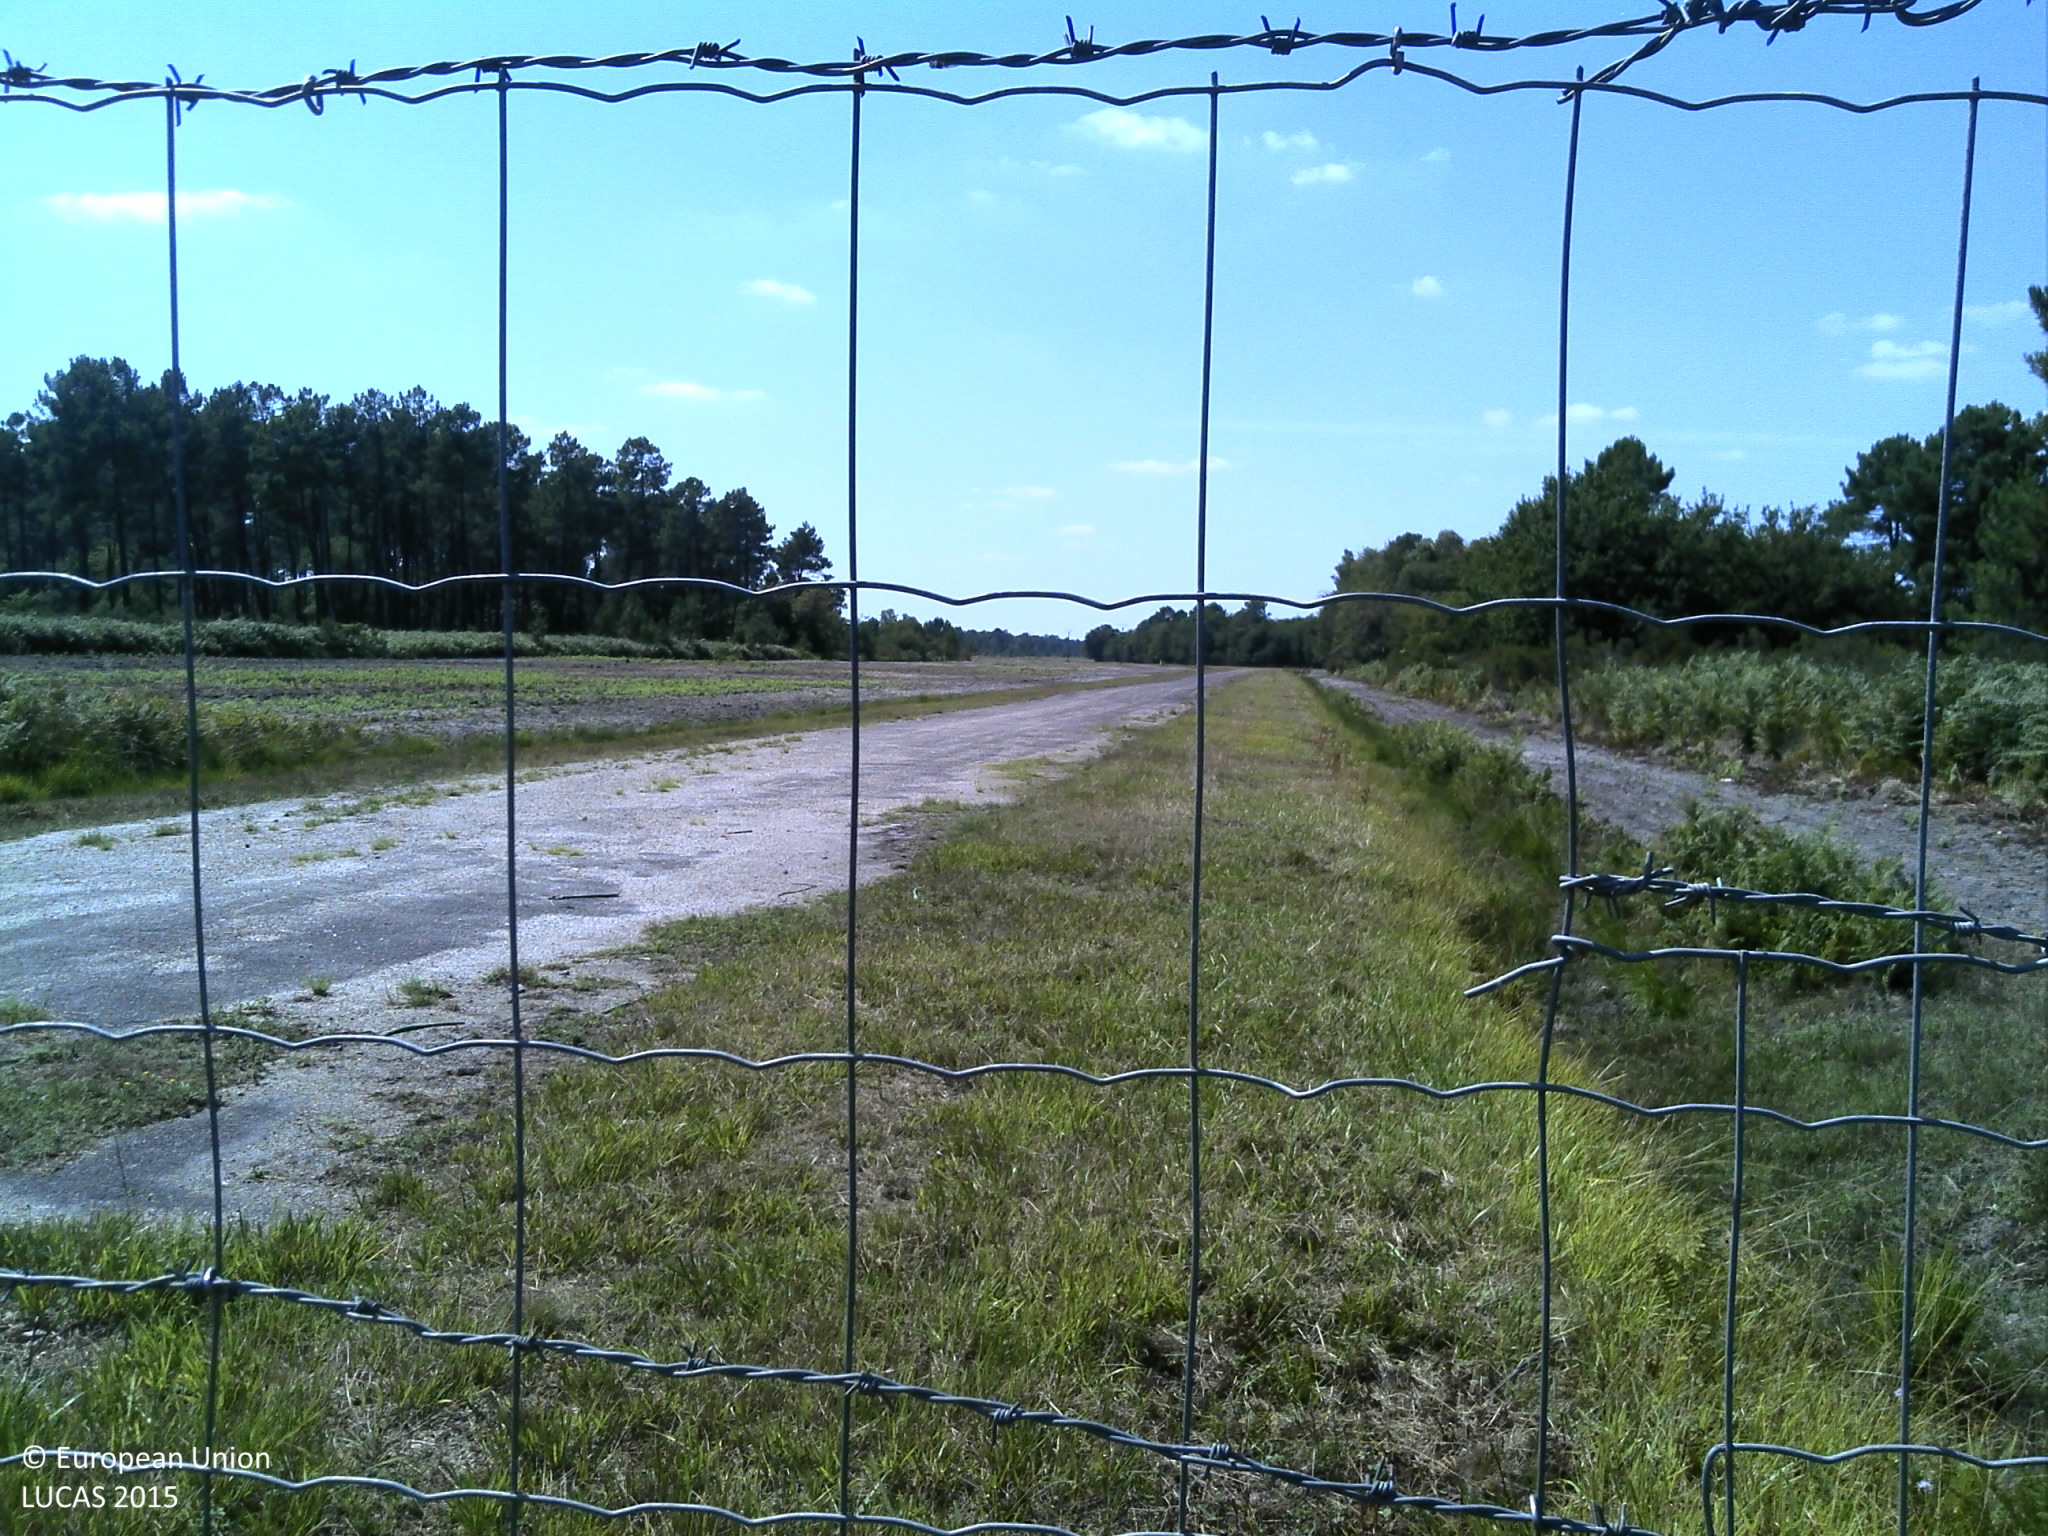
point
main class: Grassland
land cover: Spontaneously vegetated surfaces
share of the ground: > 75 %
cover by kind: herbaceous plants 95 %, shrubs 5 %
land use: Community services
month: August
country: FR
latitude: 44.2169
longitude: -0.3135
